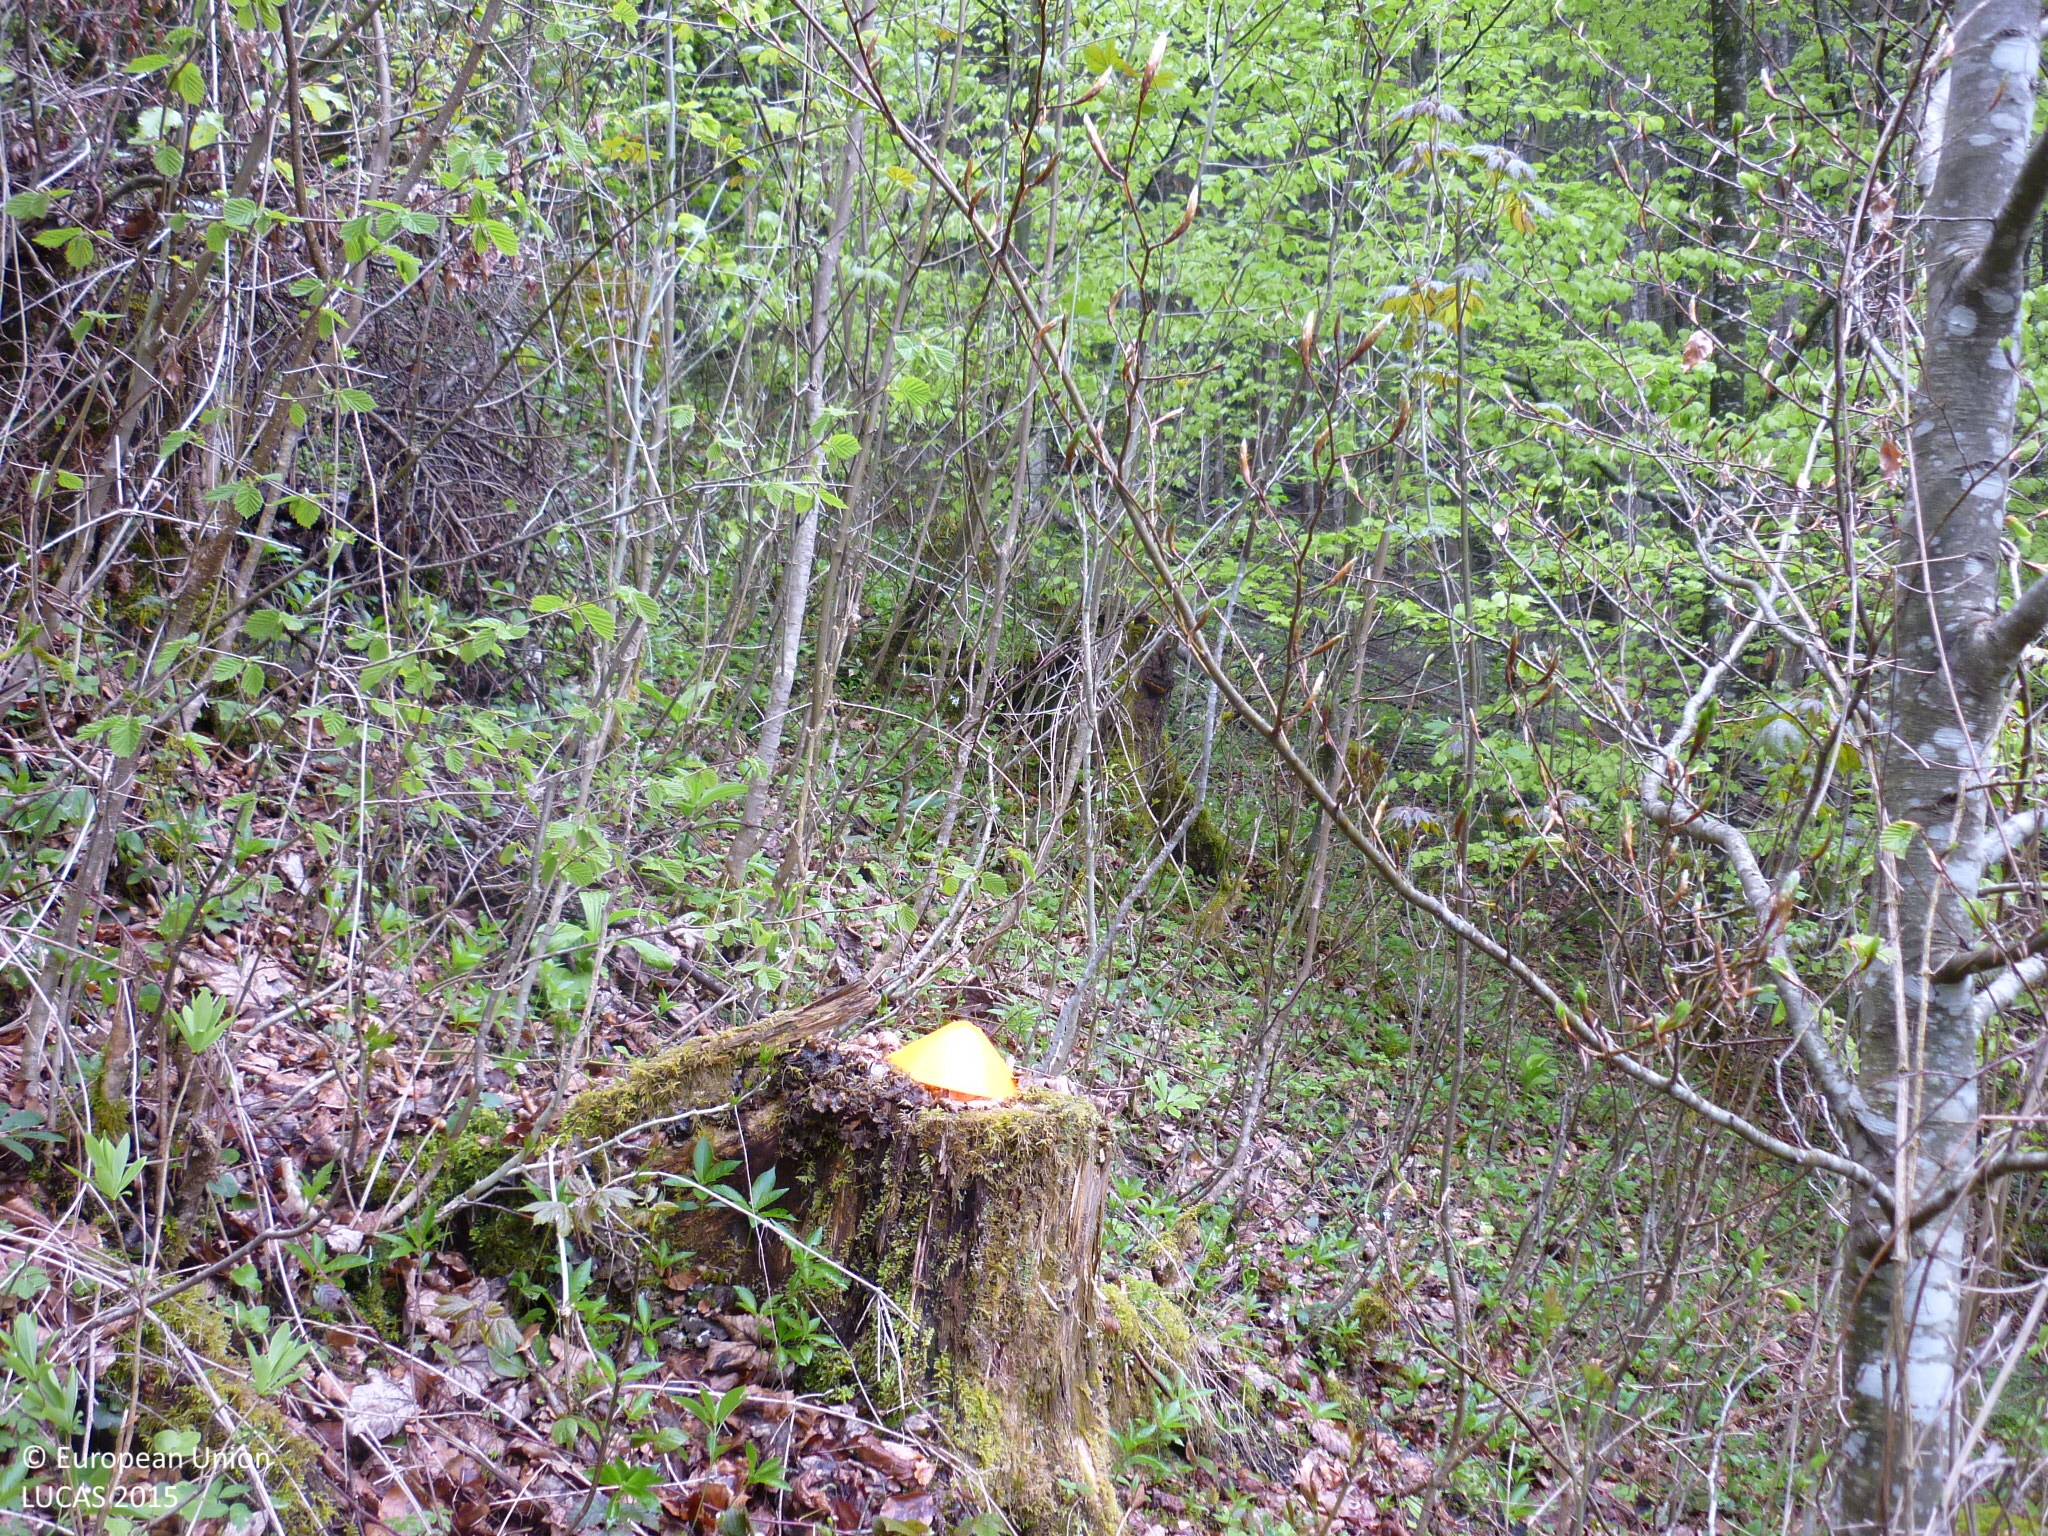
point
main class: Woodland
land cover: Broadleaved woodland
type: mountainous beech forest
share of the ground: > 75 %
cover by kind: broadleaved forest trees 90 %, coniferous forest trees 5 %, herbaceous plants 5 %
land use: Forestry
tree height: < 5 m
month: May
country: AT
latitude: 47.6917
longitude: 14.6763
